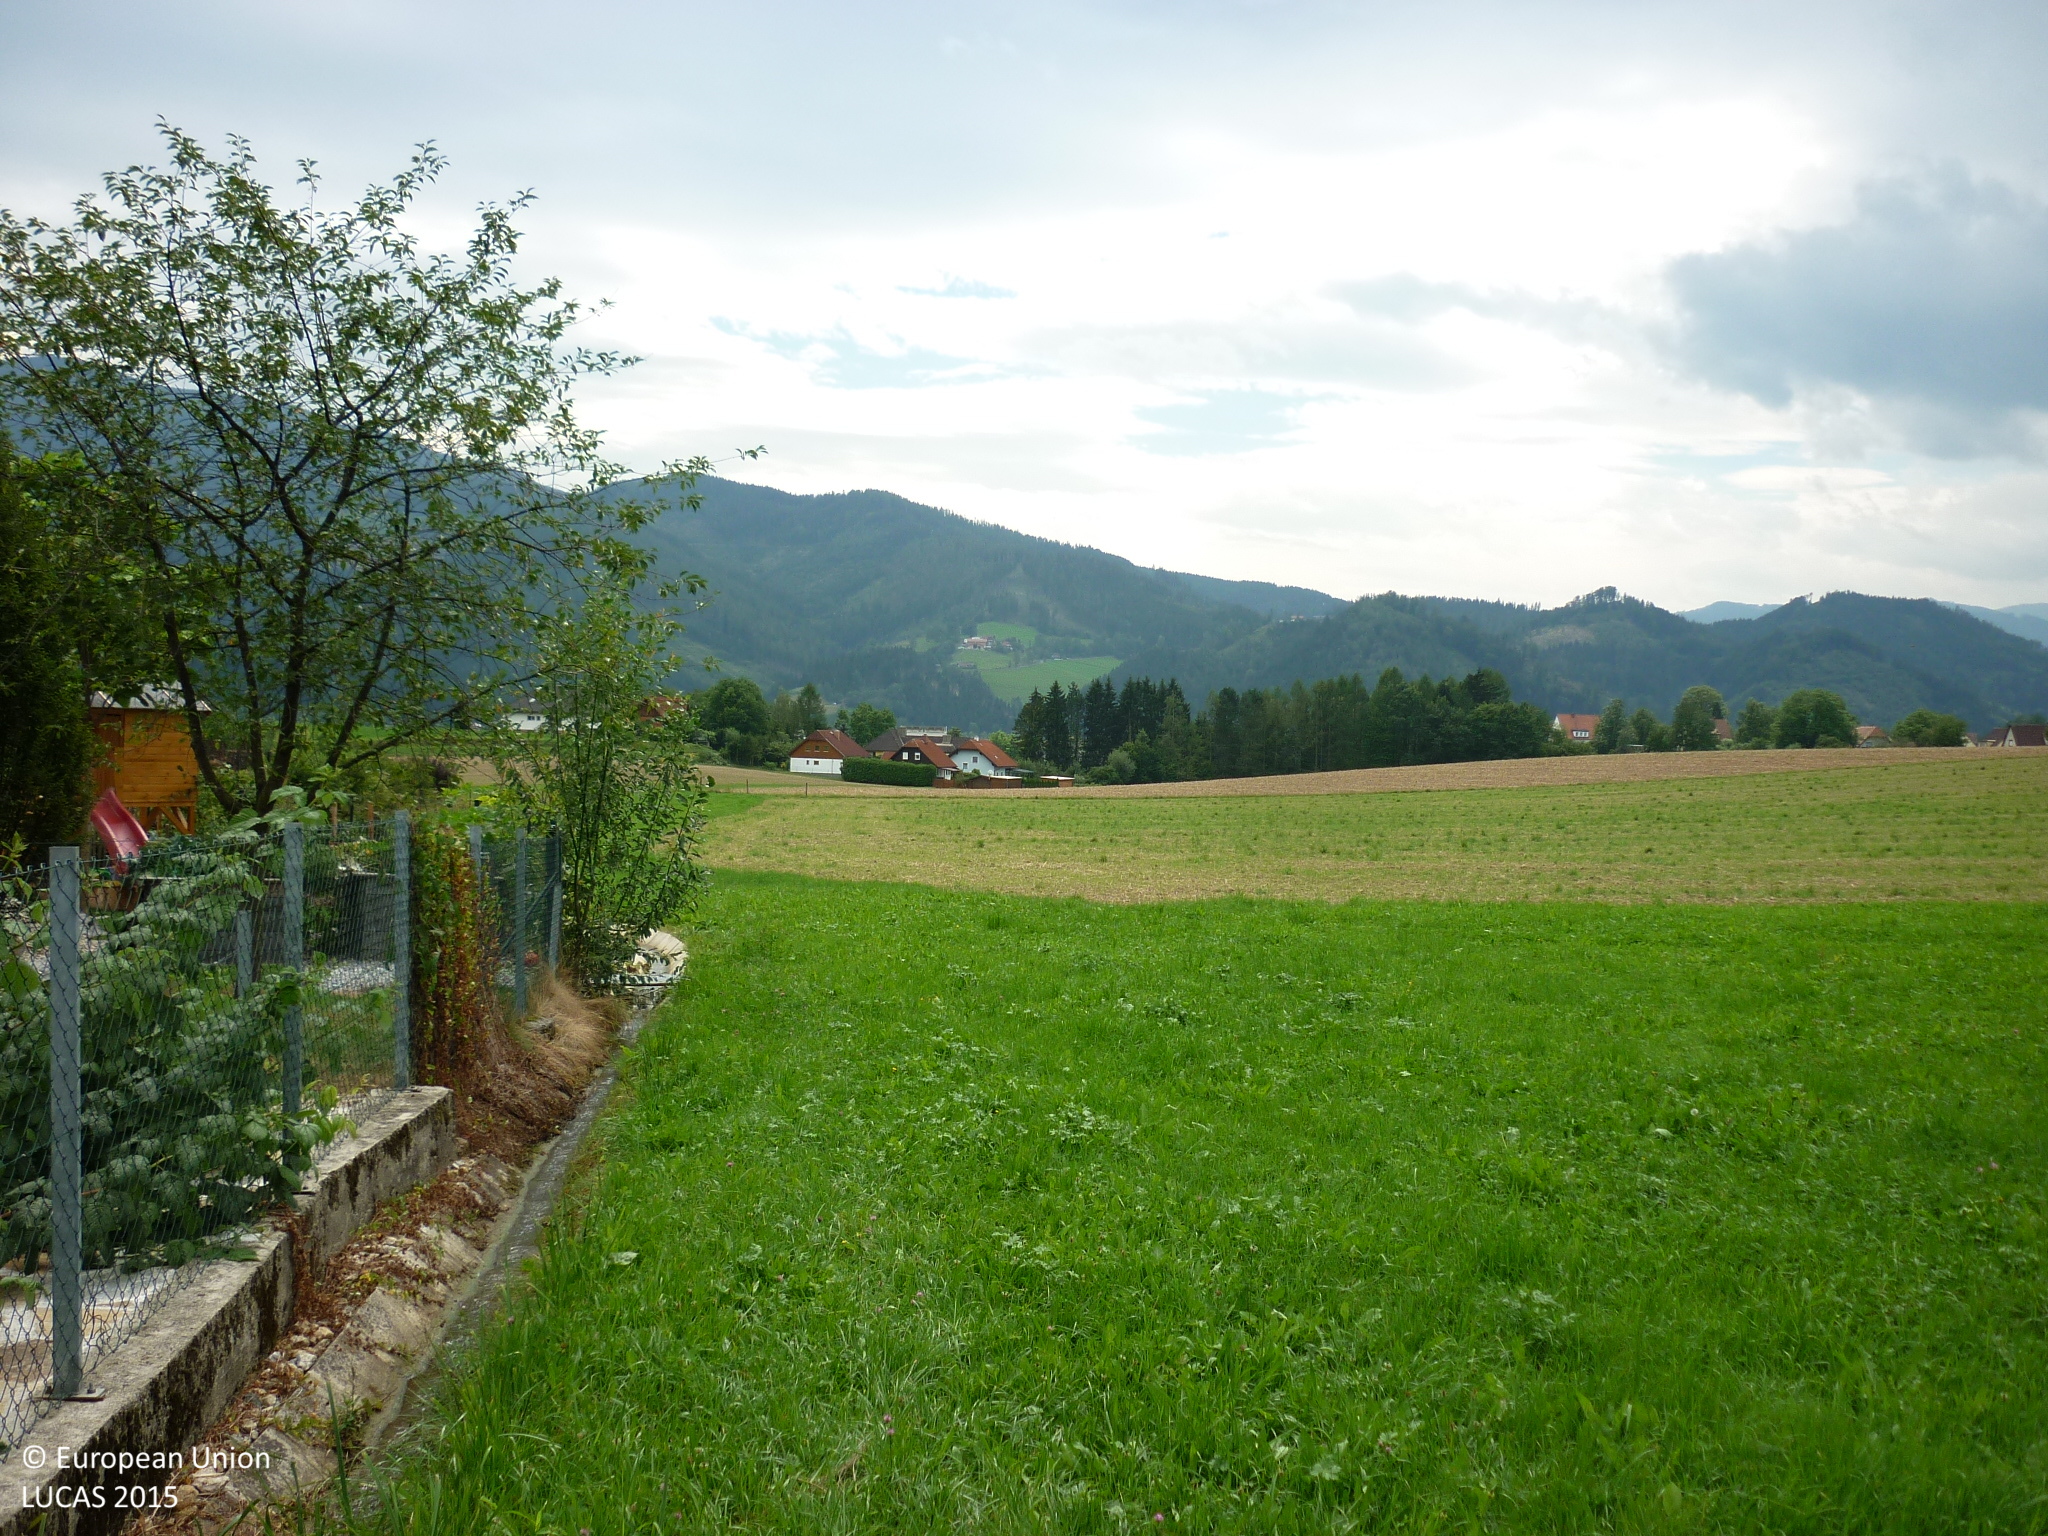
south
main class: Grassland
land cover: Grassland with sparse tree/shrub cover
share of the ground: > 75 %
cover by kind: herbaceous plants 85 %, shrubs 10 %, broadleaved forest trees 5 %
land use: Residential
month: August
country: AT
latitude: 47.4639
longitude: 15.3202
